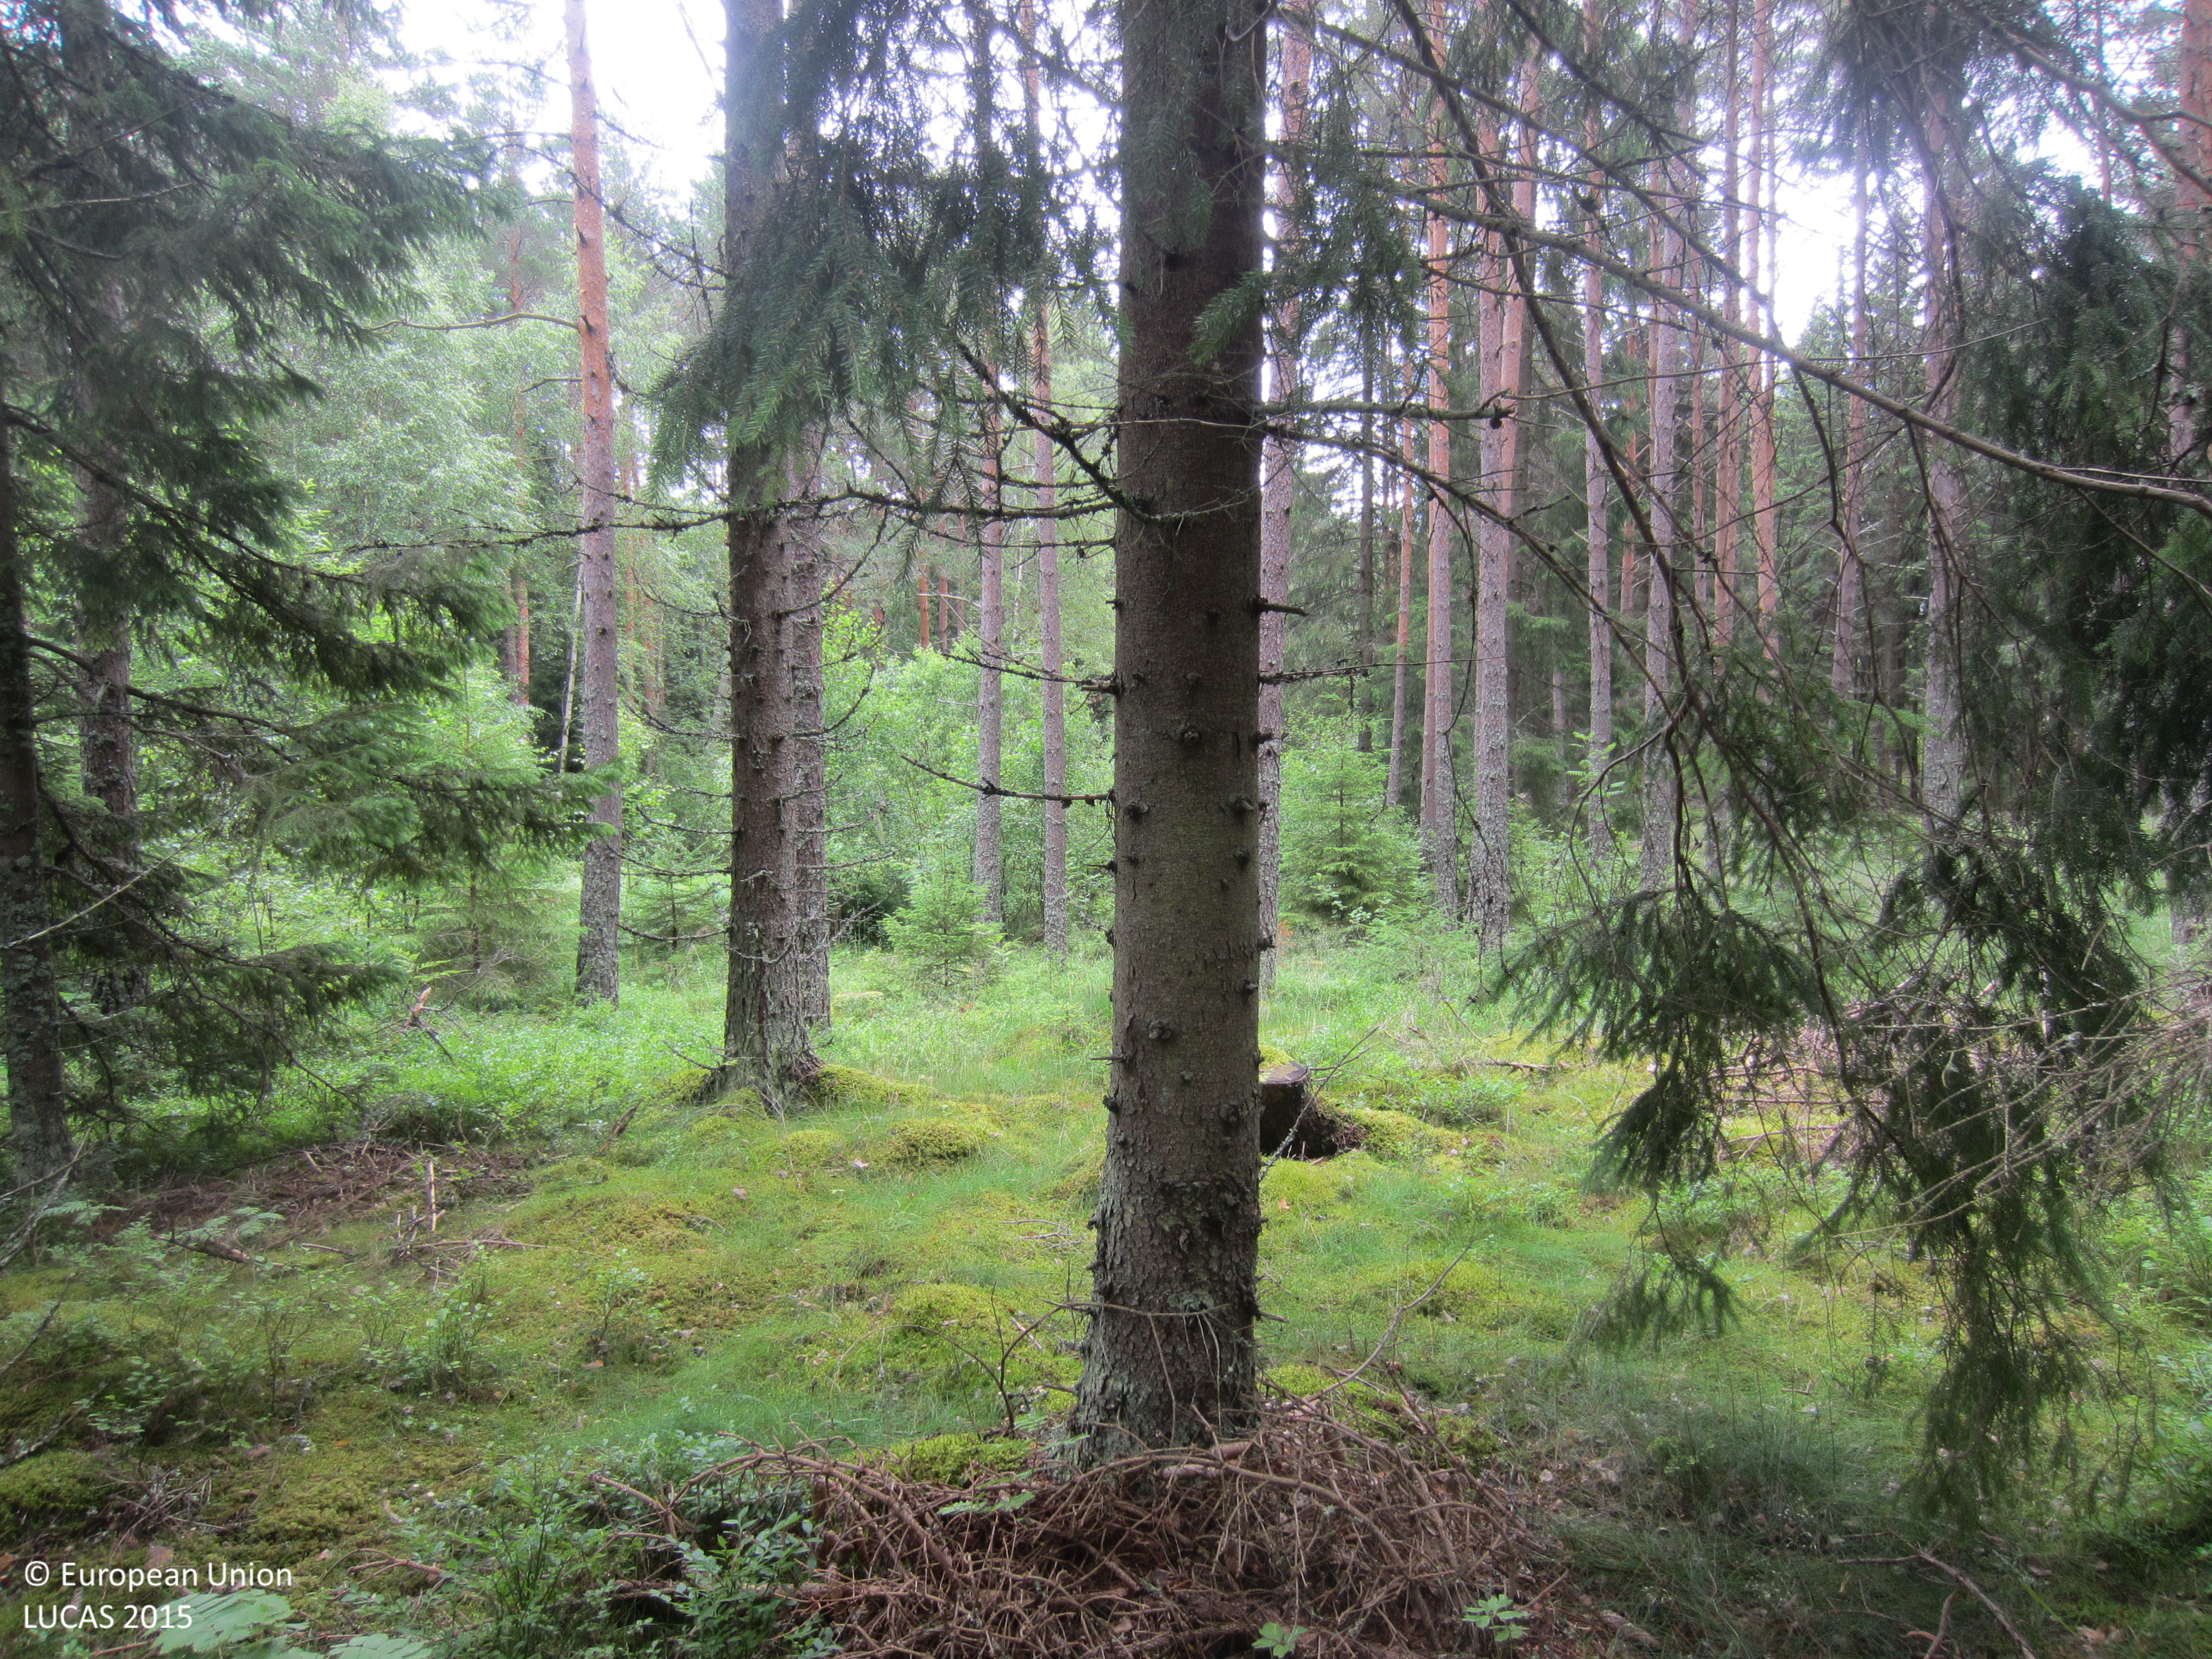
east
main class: Woodland
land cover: Spruce dominated coniferous woodland
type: boreal forest
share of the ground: > 75 %
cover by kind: coniferous forest trees 70 %, herbaceous plants 10 %, lichens and mosses 10 %, broadleaved forest trees 5 %, shrubs 5 %
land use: Forestry
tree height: > 5 m
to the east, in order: Spruce dominated coniferous woodland; Broadleaved woodland; Ditches and canals; Grass margins; Tracks; Grass margins; Pine dominated coniferous woodland; Ditches and canals; Spruce dominated coniferous woodland; Other coniferous woodland; Broadleaved woodland
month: July
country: SE
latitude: 59.8241
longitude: 17.0376
